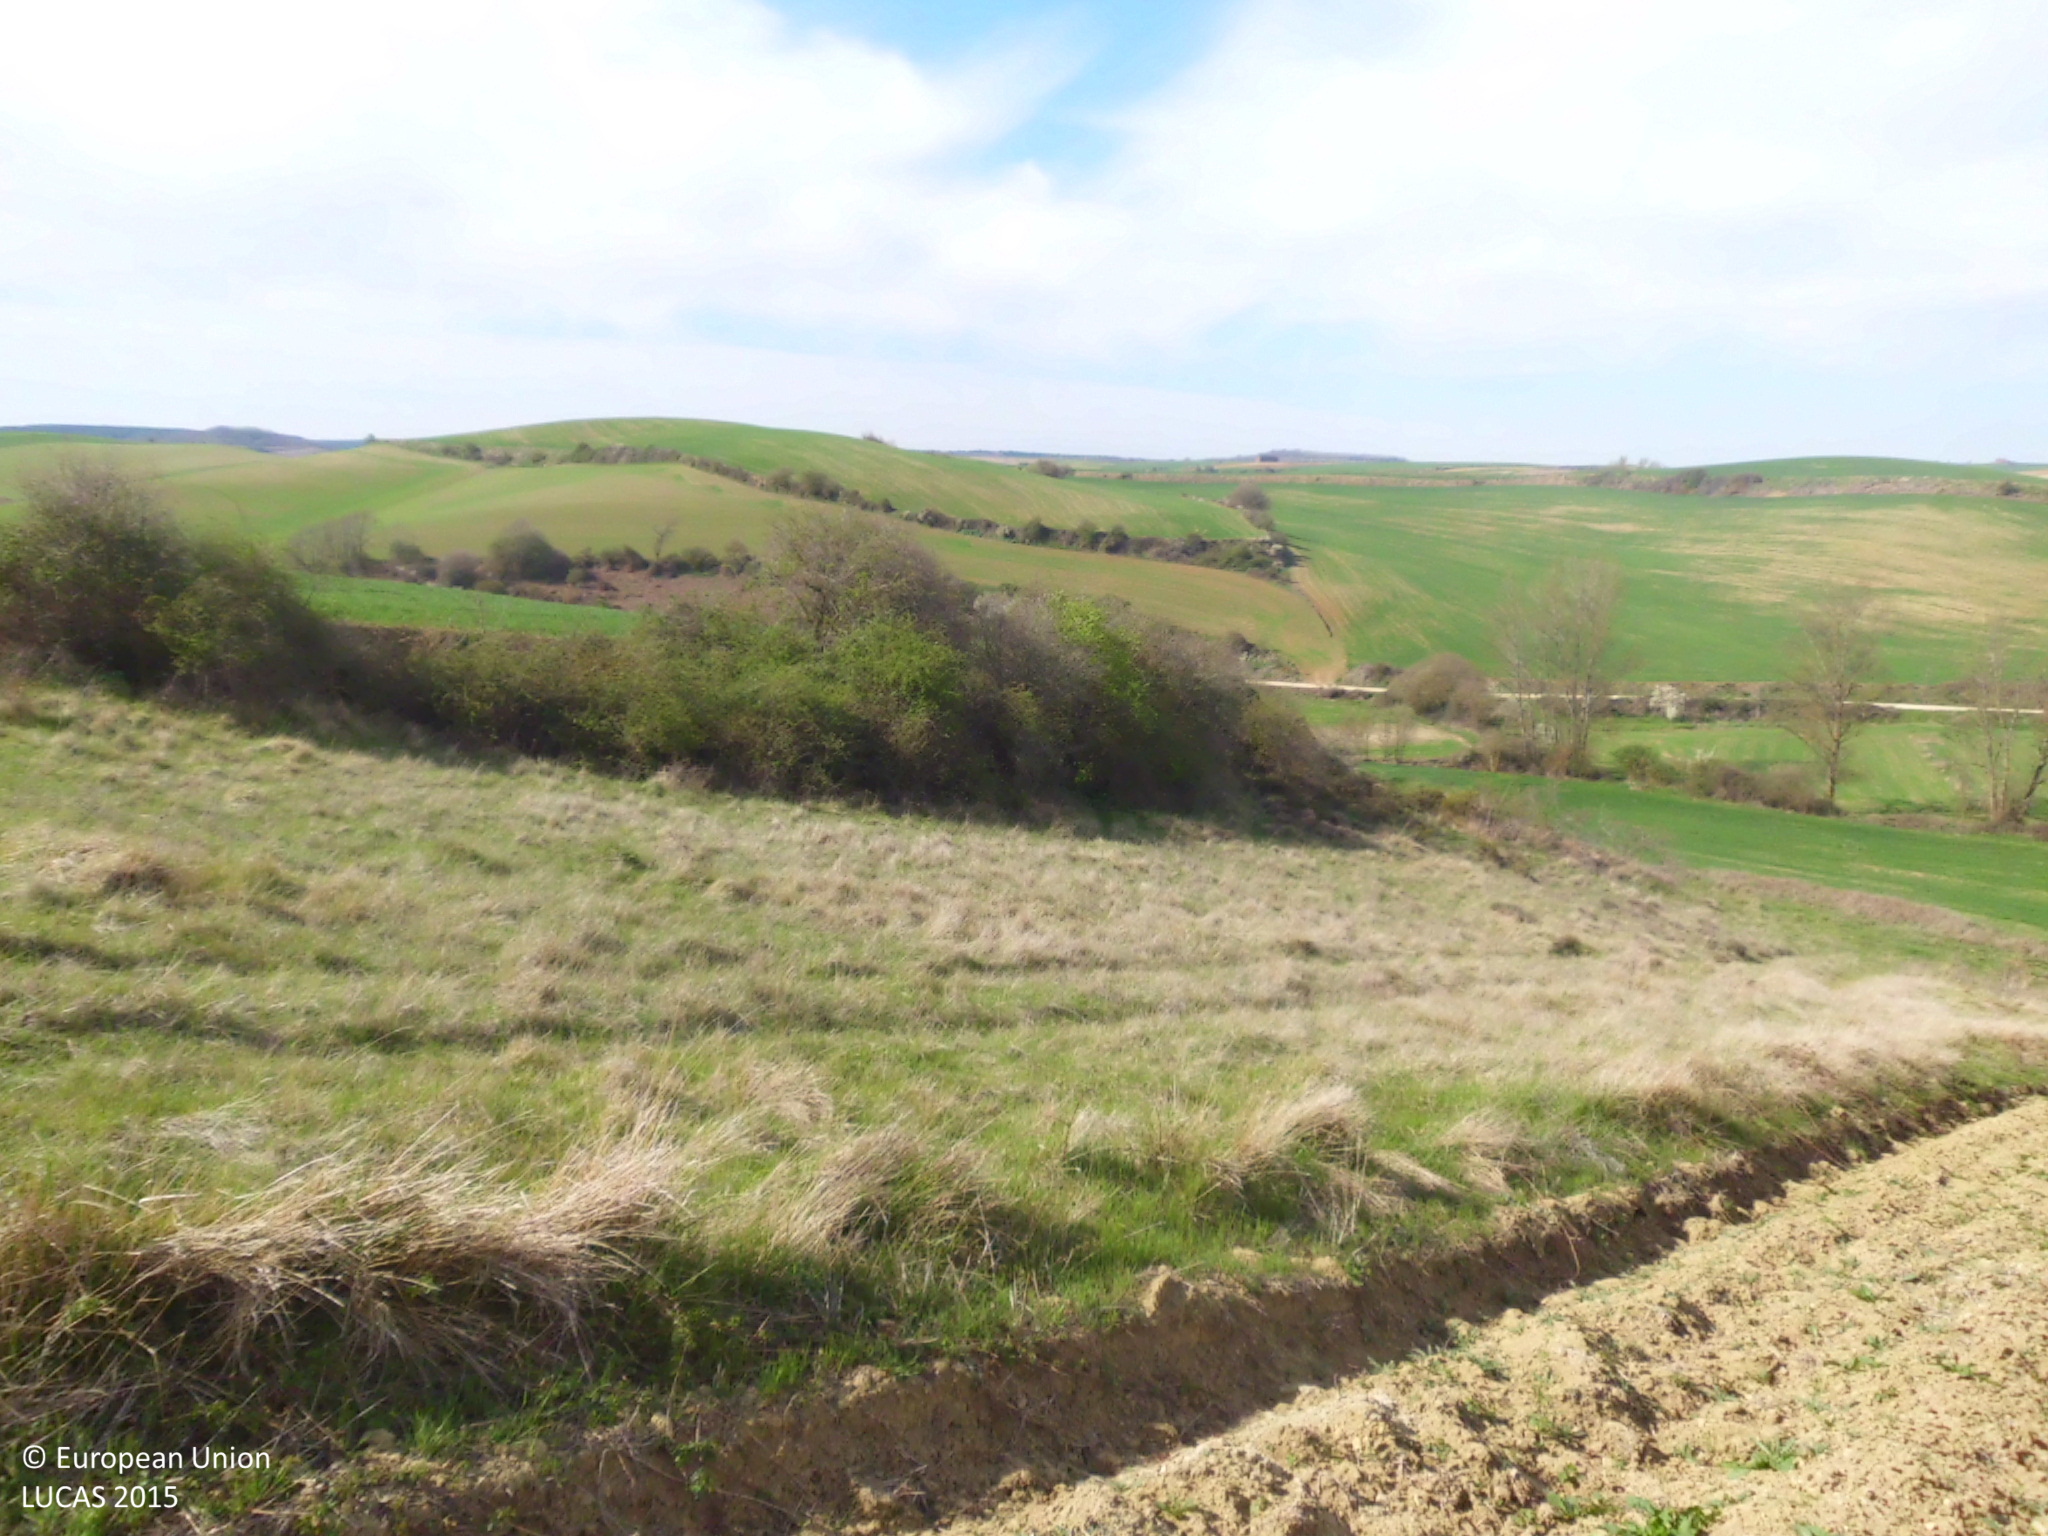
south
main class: Grassland
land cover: Spontaneously vegetated surfaces
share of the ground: 10 - 25 %
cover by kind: unconsolidated bare surface 85 %, herbaceous plants 15 %
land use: Fallow land
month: April
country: ES
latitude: 42.4156
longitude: -3.4123
